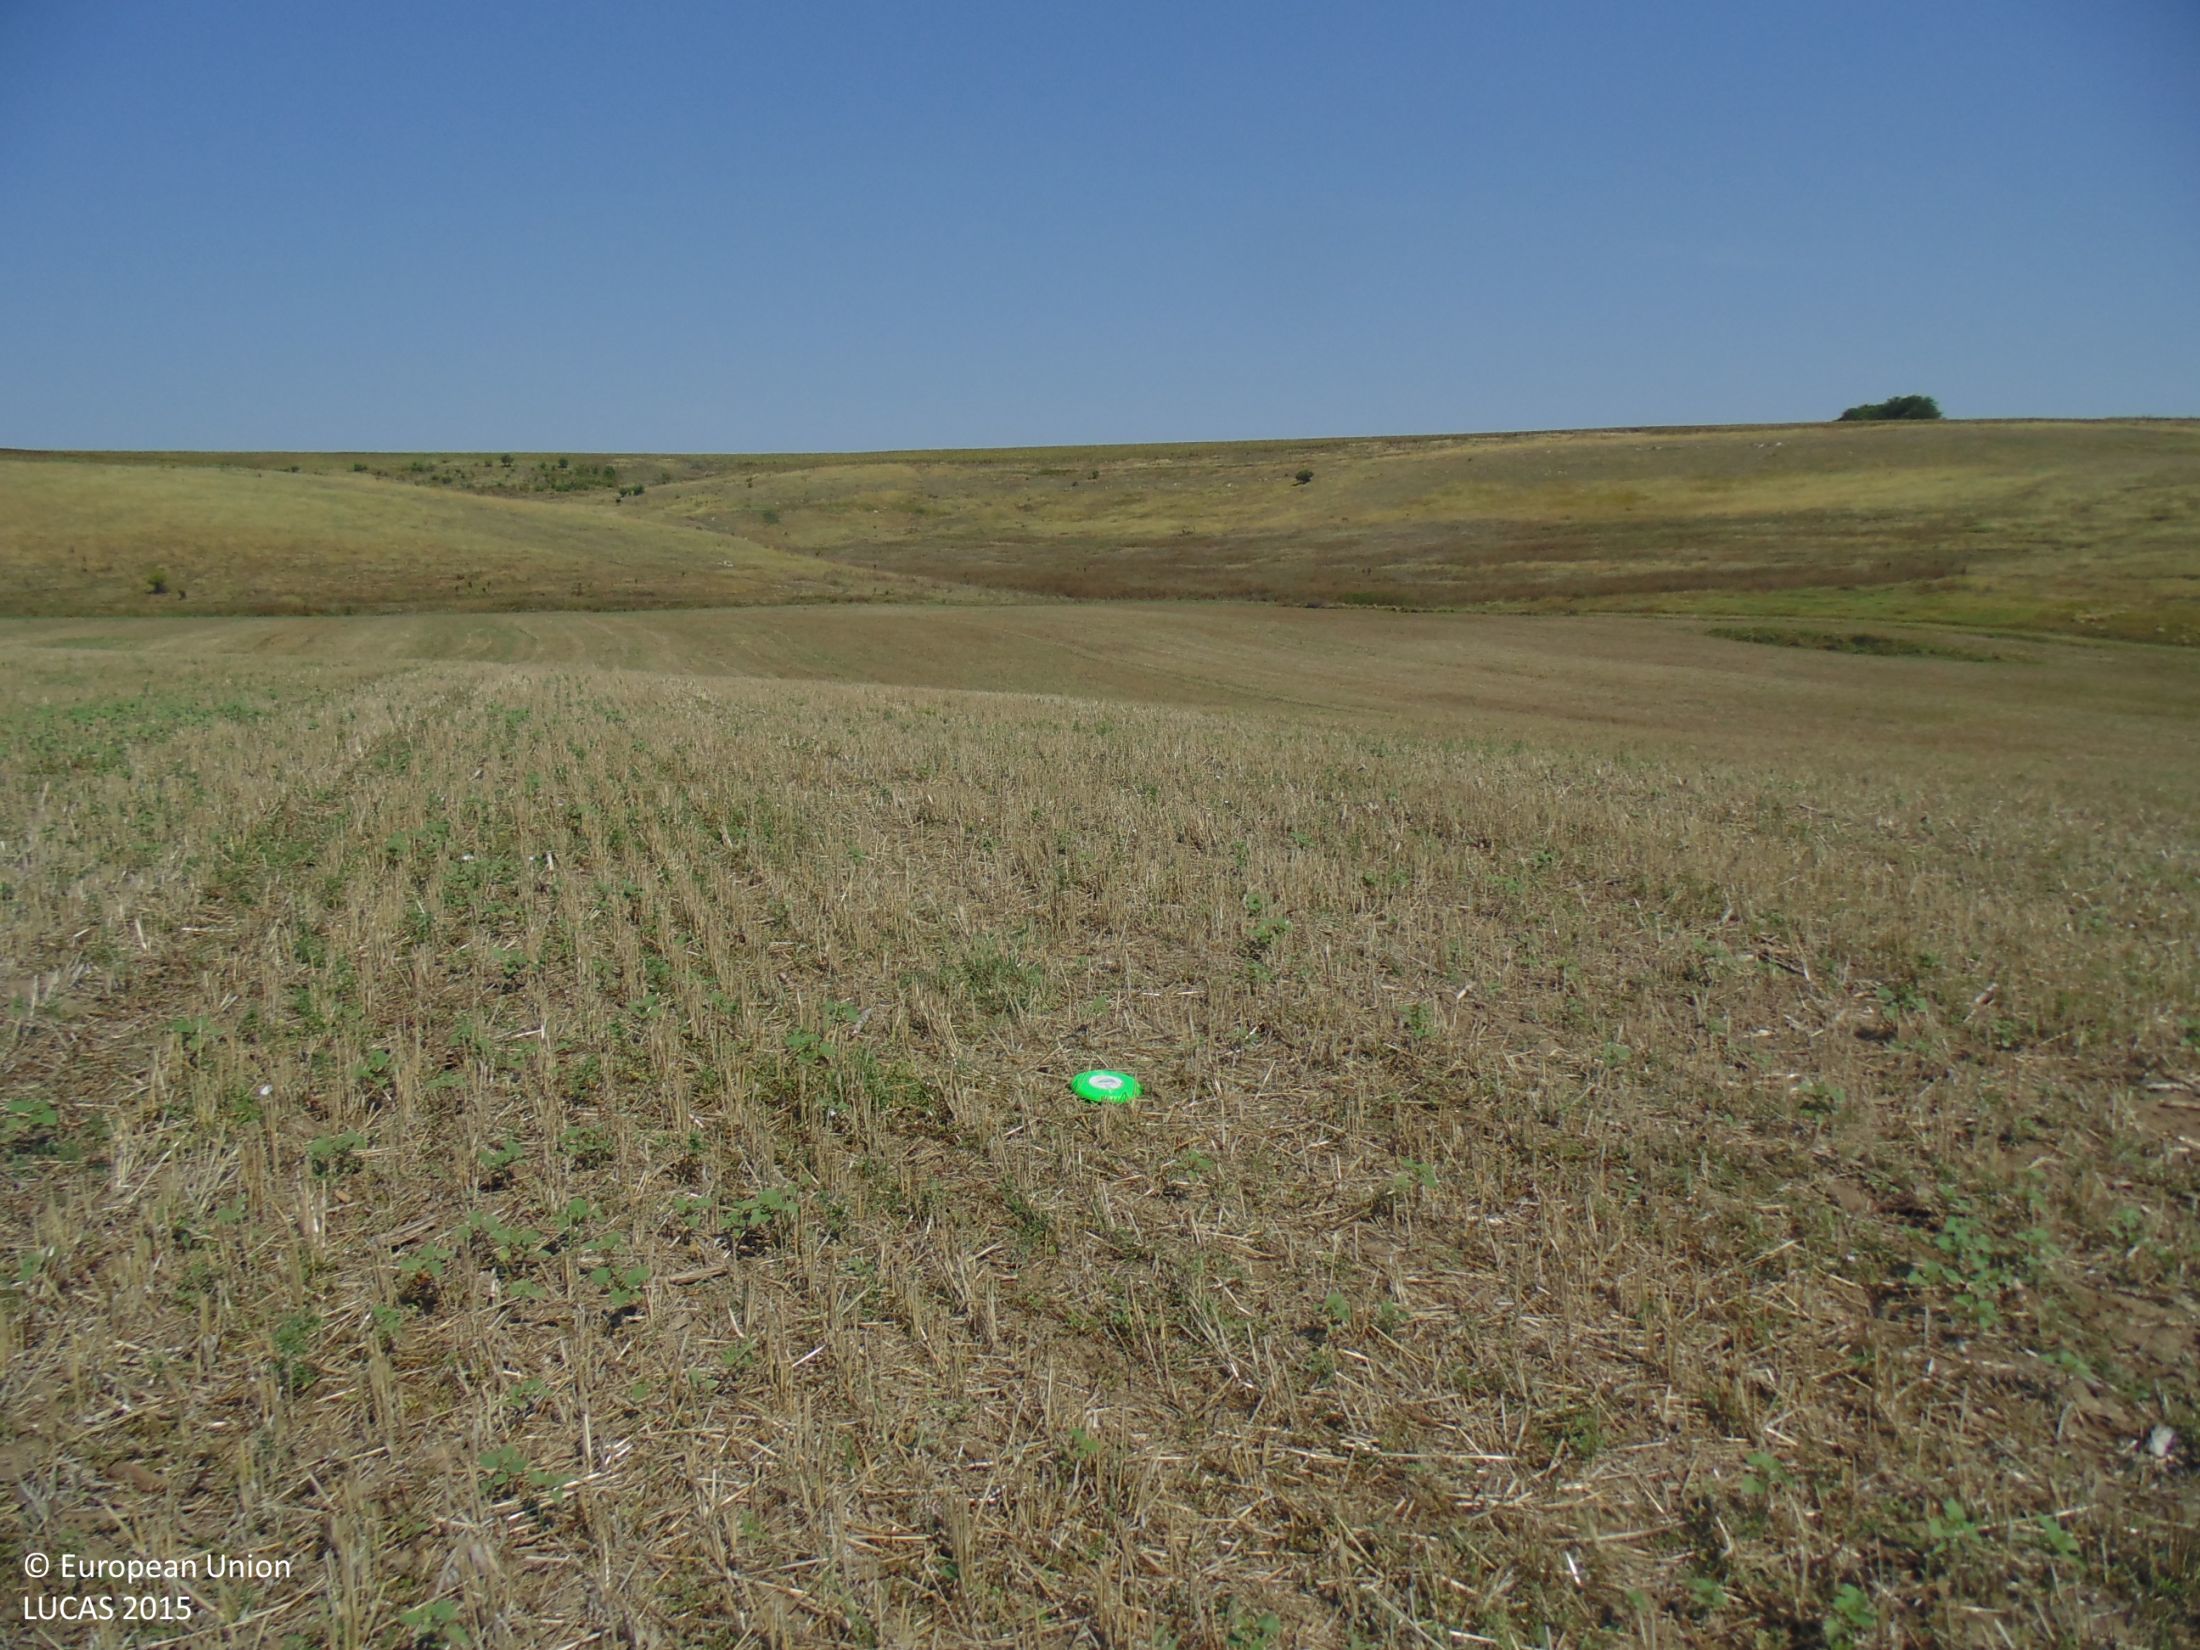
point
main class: Cropland
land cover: Common wheat
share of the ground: 10 - 25 %
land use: Agriculture (excluding fallow land and kitchen gardens)
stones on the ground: < 10 %
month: August
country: BG
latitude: 43.7022
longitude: 27.4680
